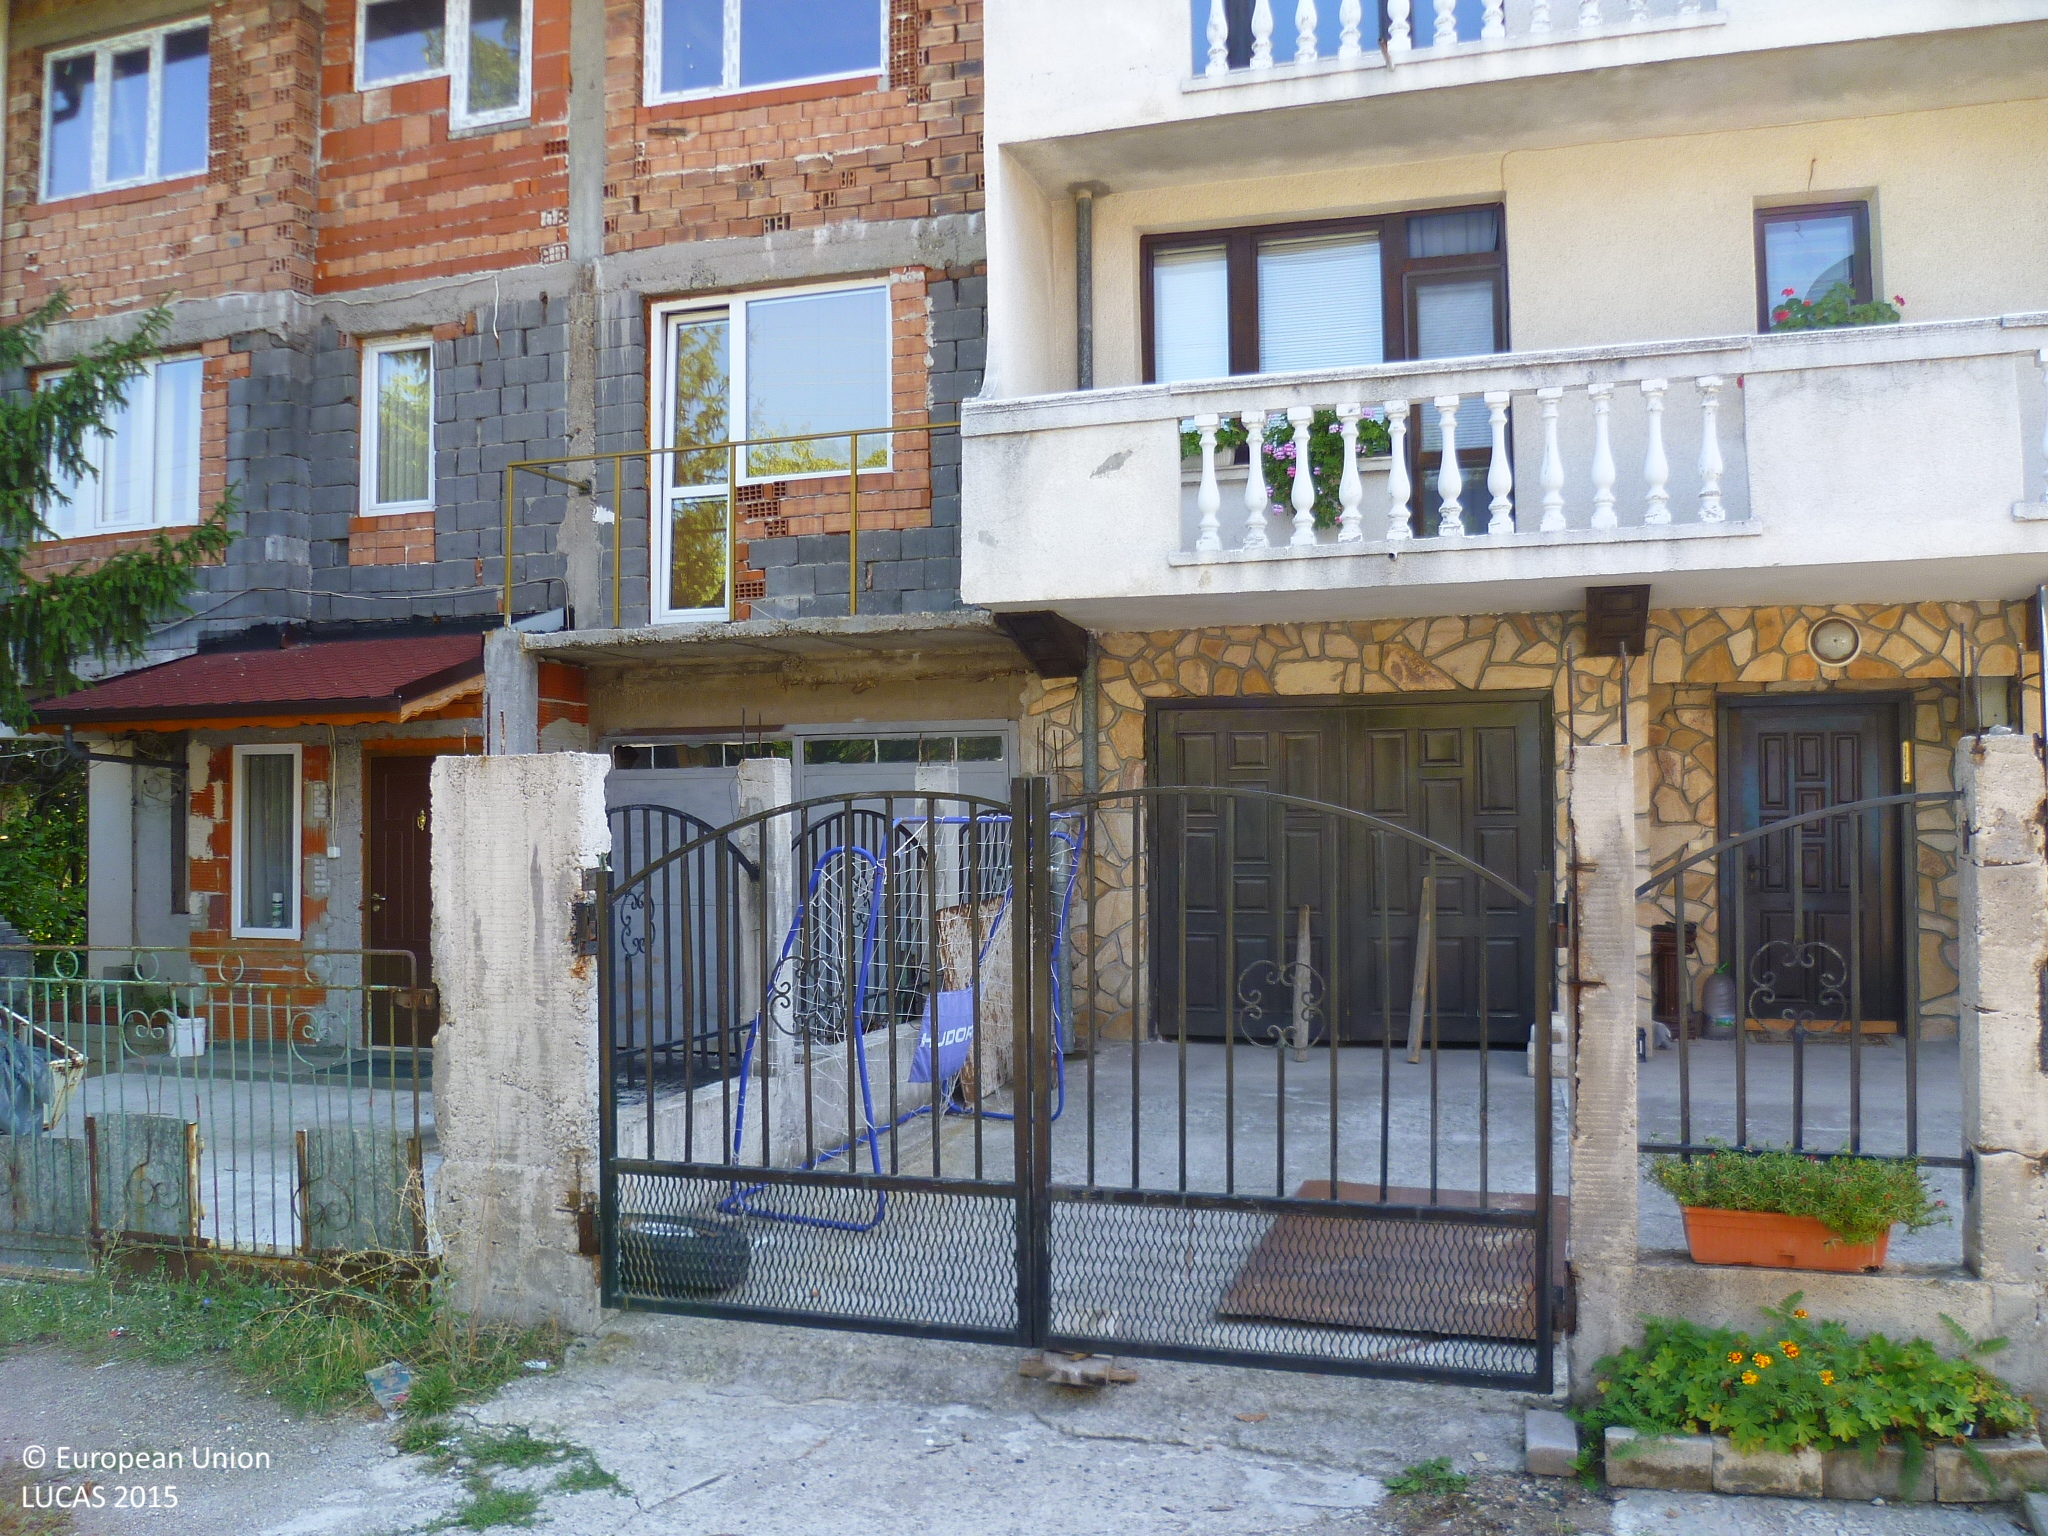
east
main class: Woodland
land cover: Broadleaved woodland
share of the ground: > 75 %
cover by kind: broadleaved forest trees 100 %
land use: Residential
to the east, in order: Broadleaved woodland; Artificial constructions in urban areas
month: September
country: BG
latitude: 42.5936
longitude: 23.0324
